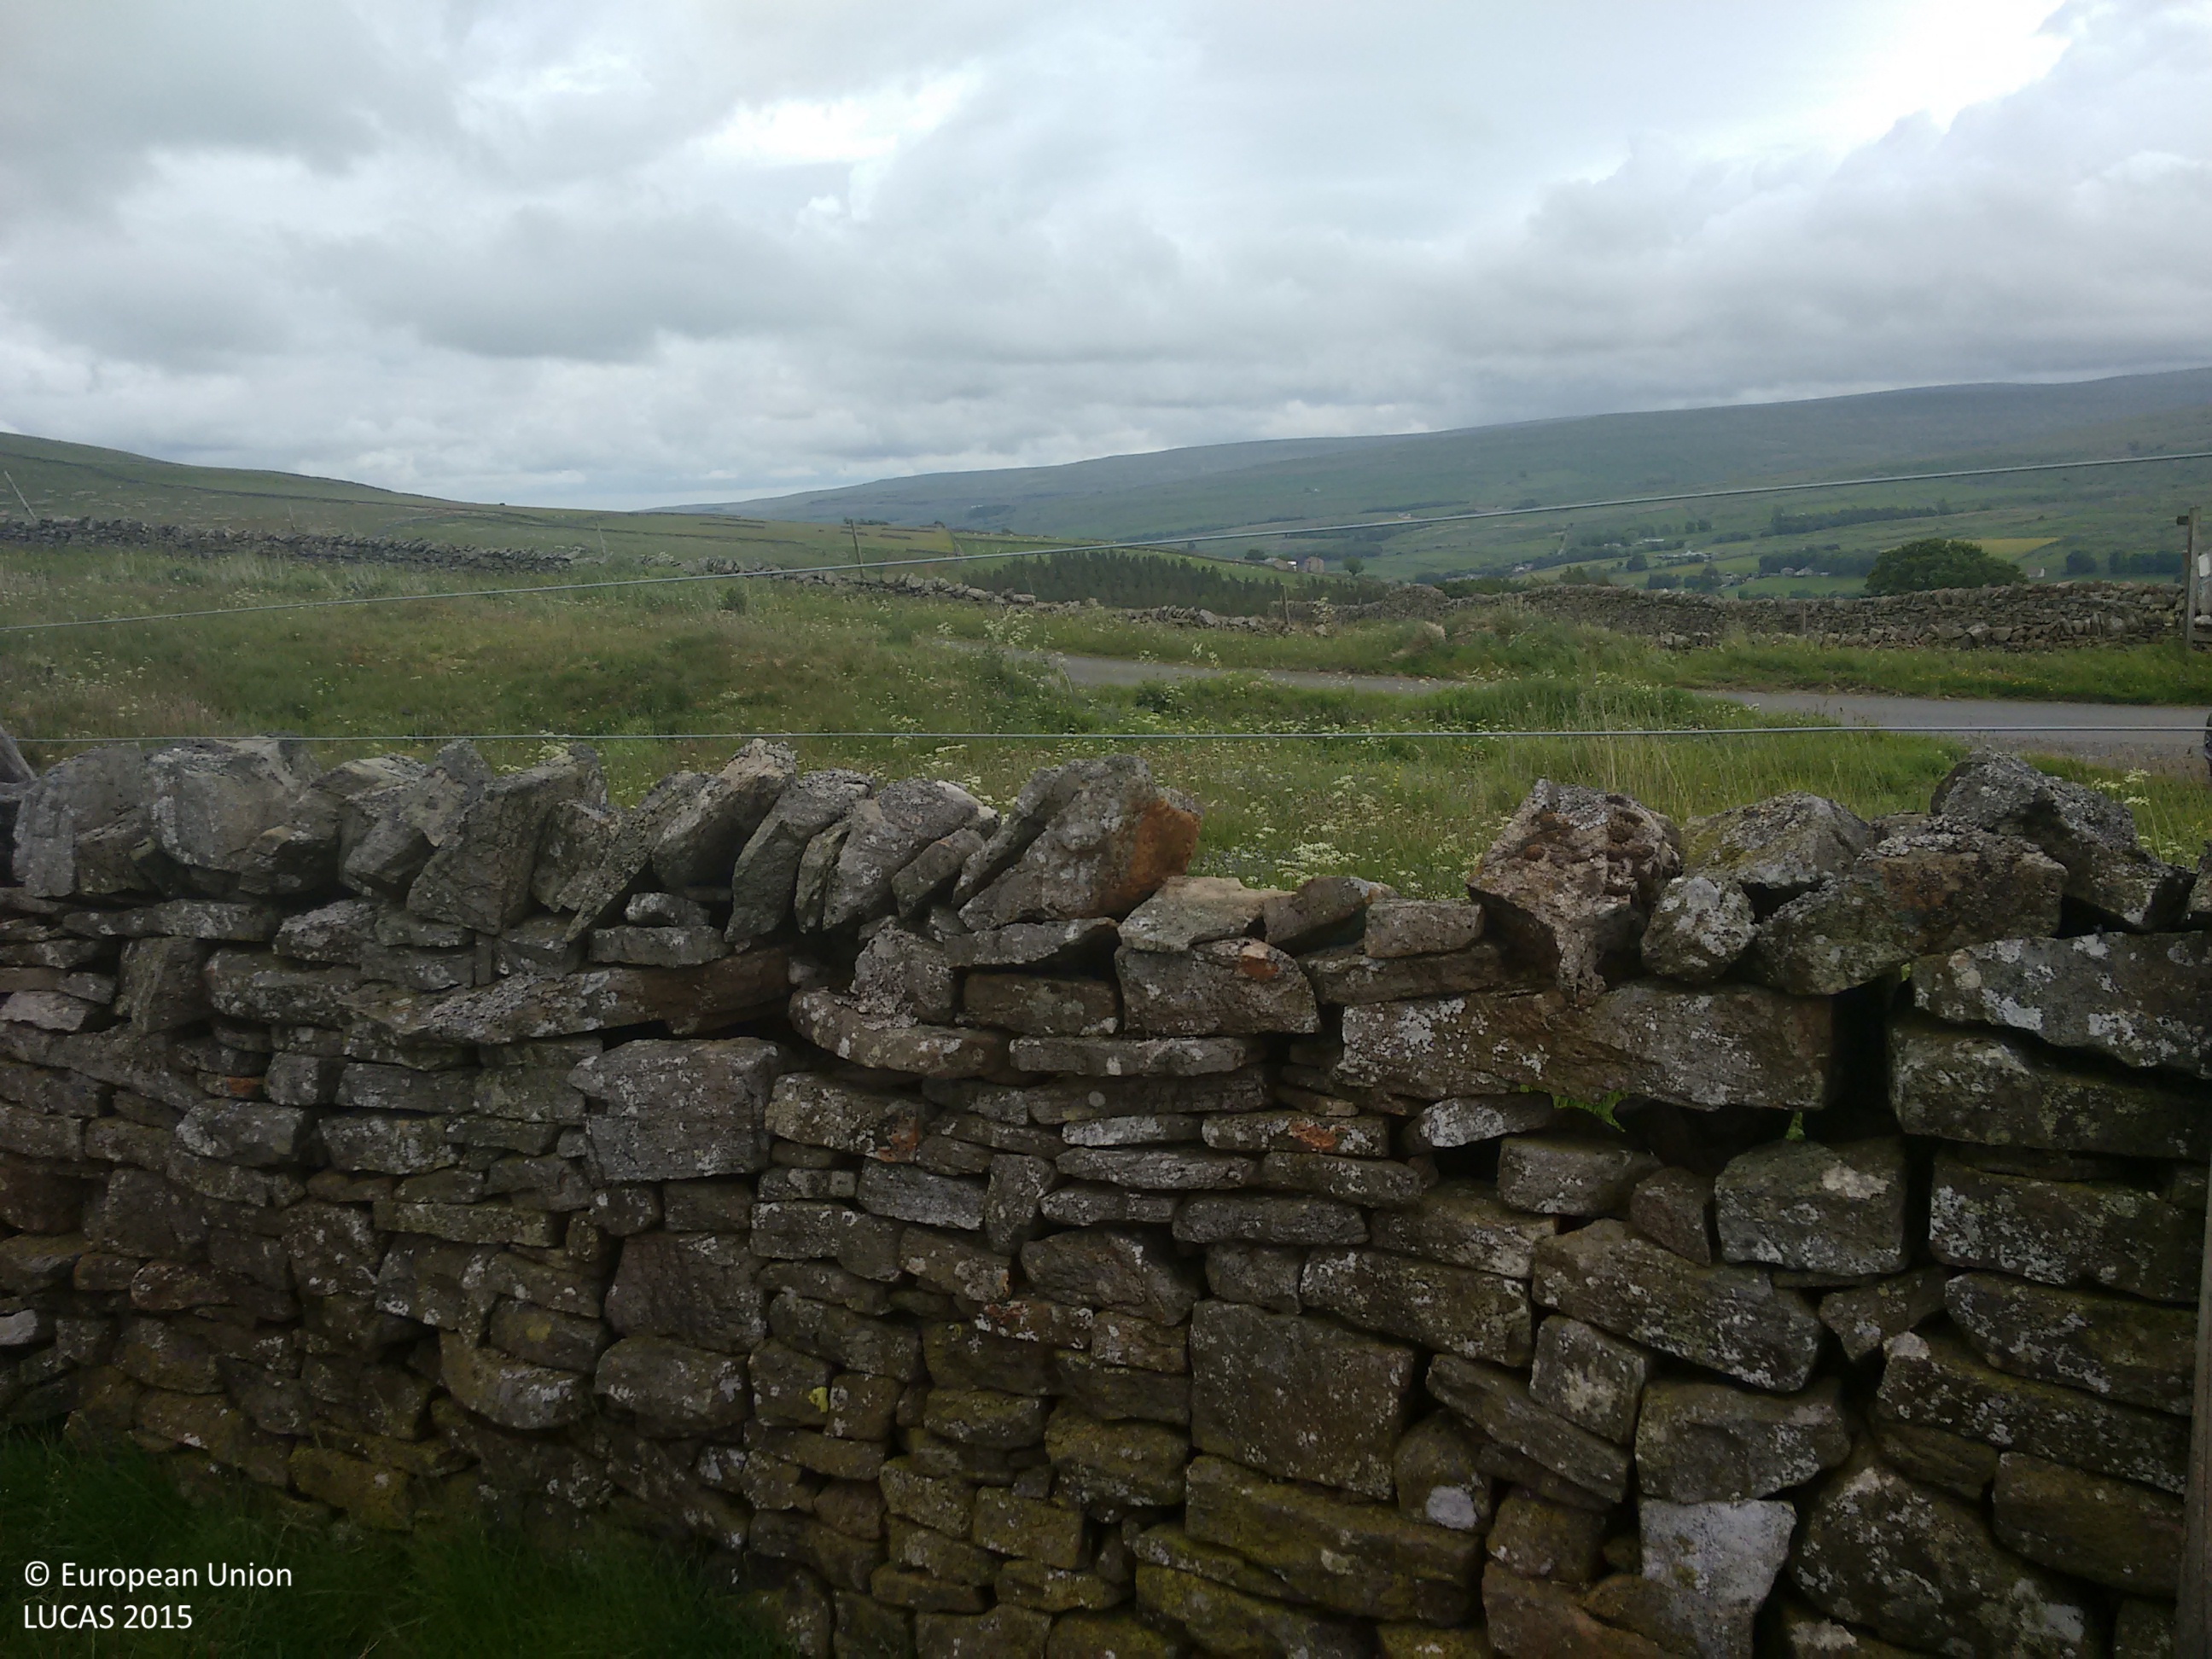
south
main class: Grassland
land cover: Grassland without tree/shrub cover
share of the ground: > 75 %
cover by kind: herbaceous plants 100 %
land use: Agriculture (excluding fallow land and kitchen gardens)
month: June
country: GB
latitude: 54.7482
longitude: -2.1916
